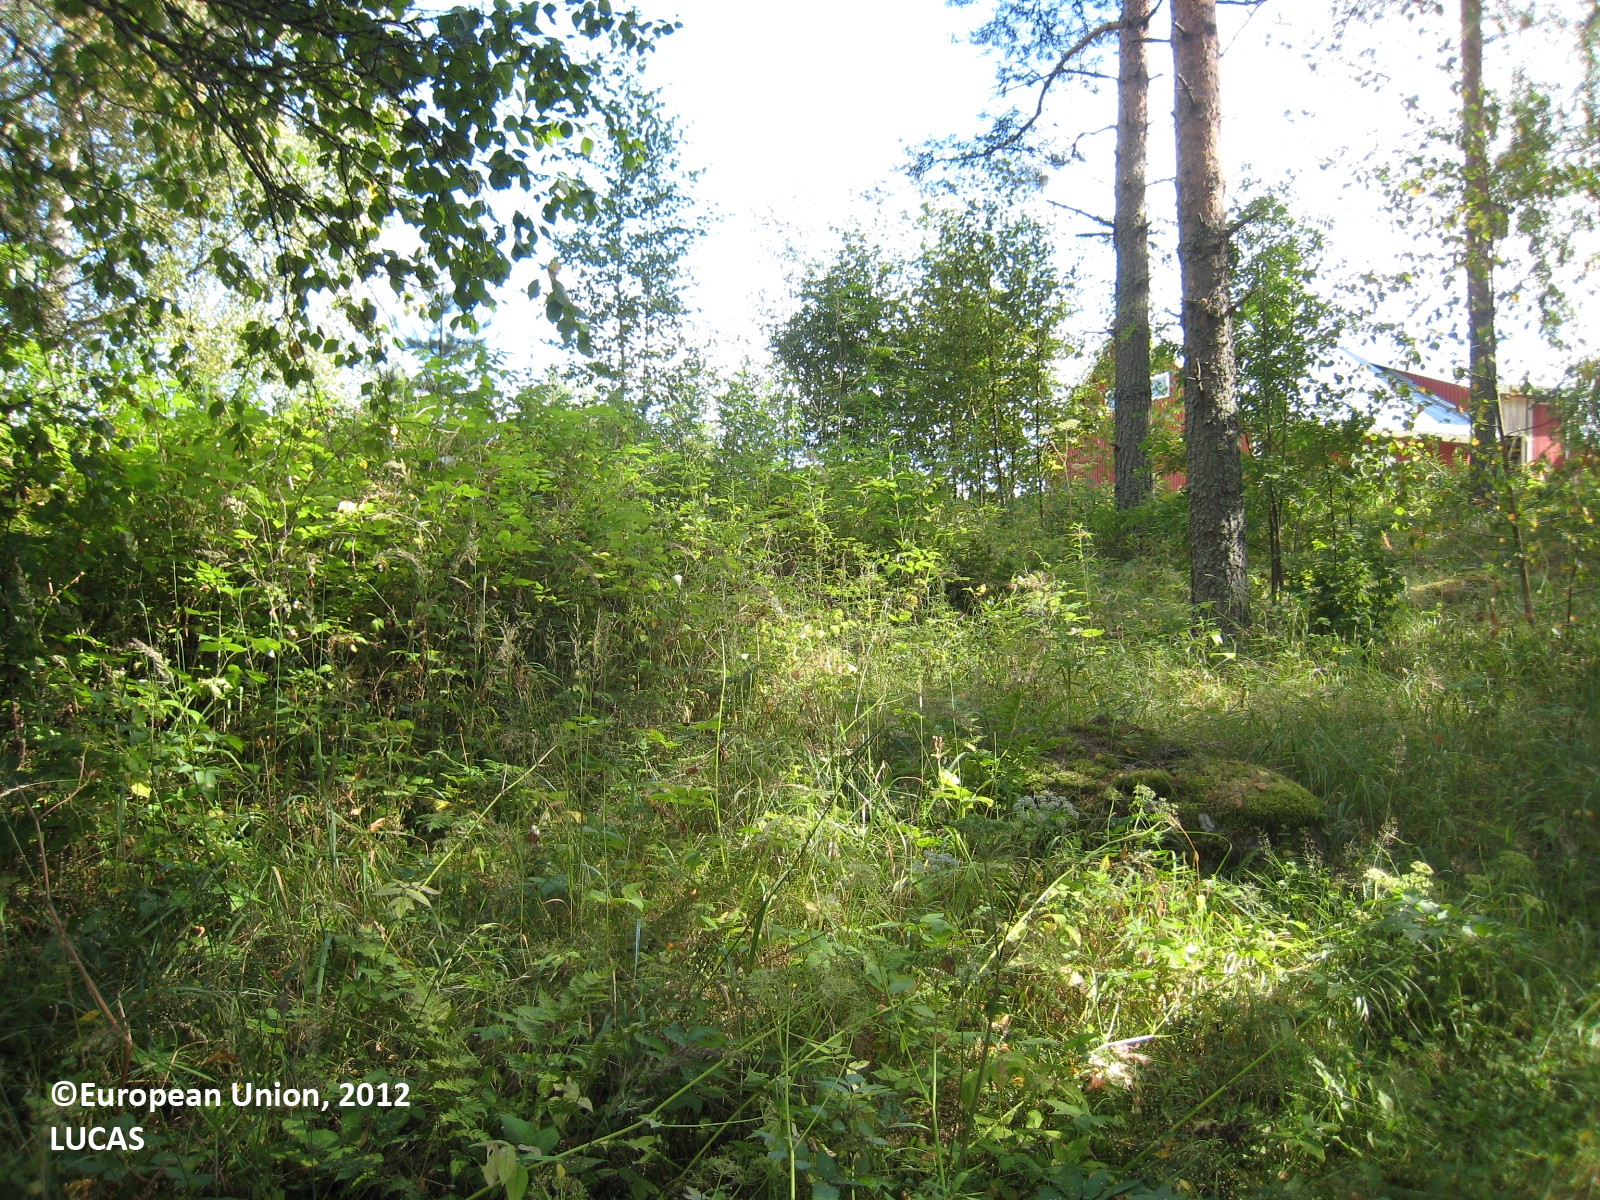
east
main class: Woodland
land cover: Other mixed woodland
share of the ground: 50 - 75 %
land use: Semi-natural and natural areas not in use
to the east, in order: Other mixed woodland; Grass margins; Tracks; Broadleaved woodland; Grassland without tree/shrub cover; Sand; Tracks; Shruby margins; Temporary grasslands; Shruby margins; Ditches and canals; Shruby margins; Temporary grasslands; Shruby margins; Dry stone walls; Spruce dominated mixed woodland; Ditches and canals; Other mixed woodland; Spruce dominated mixed woodland
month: August
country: FI
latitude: 61.9460
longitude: 27.1838
